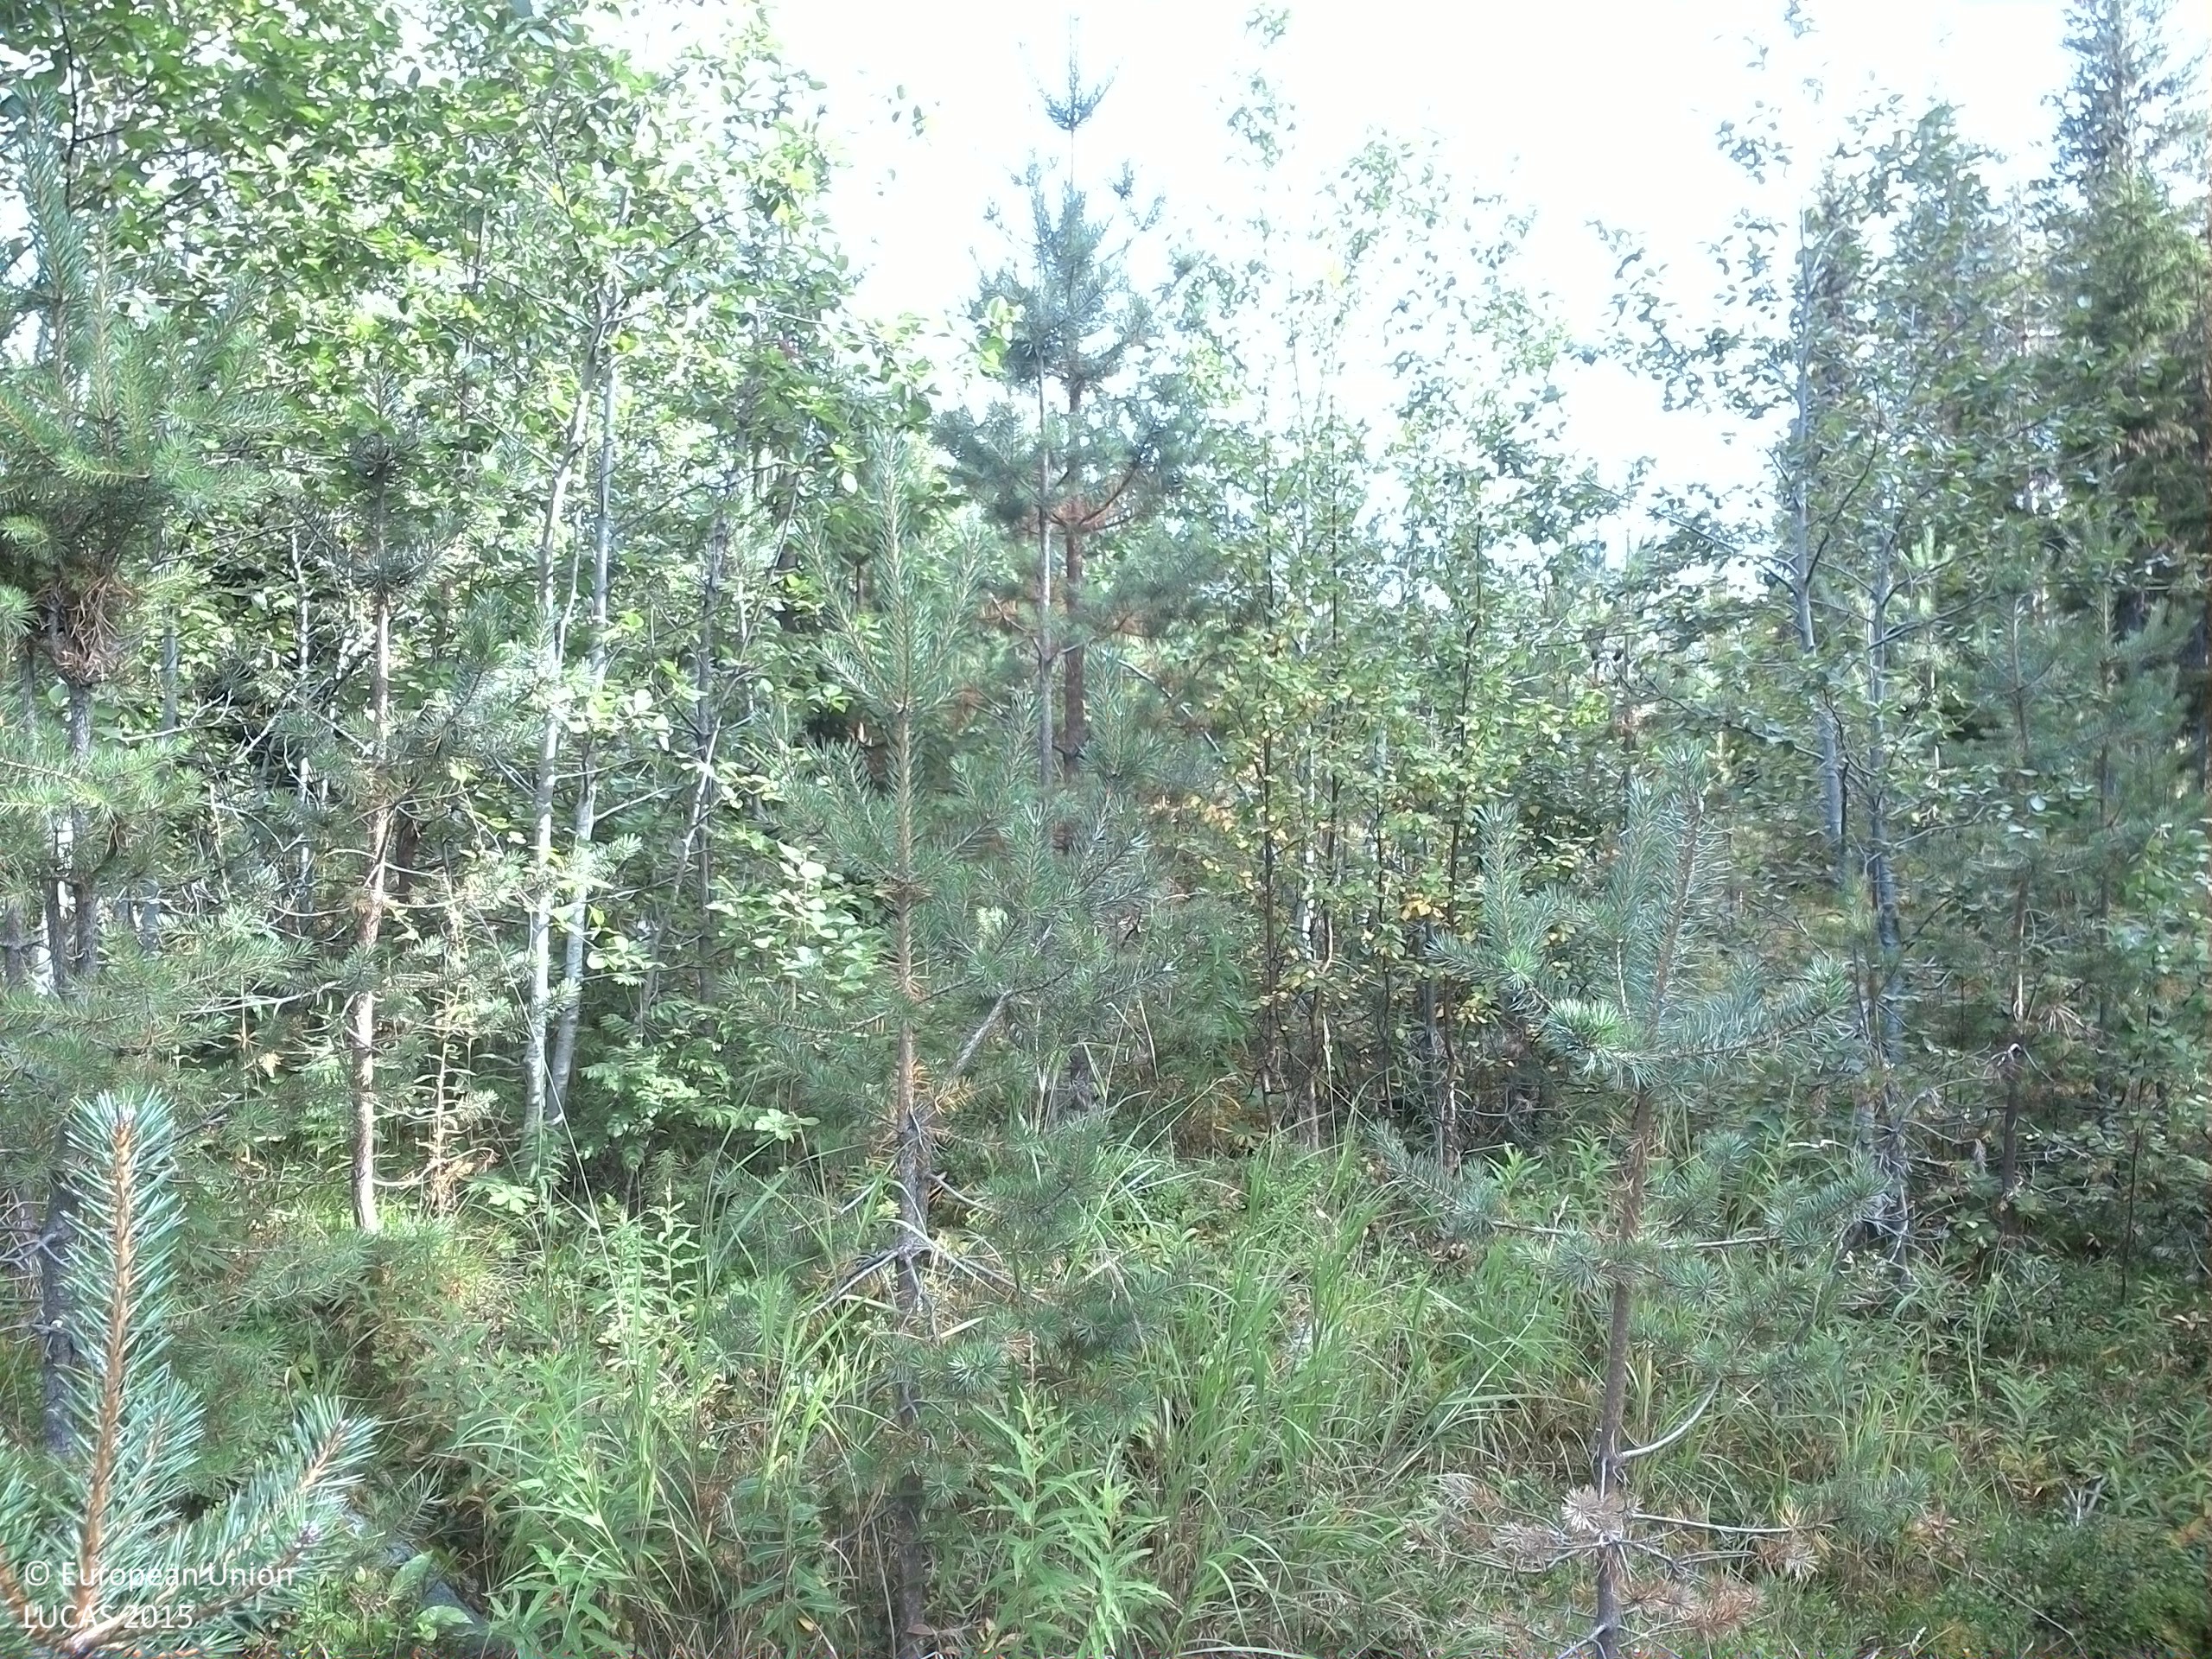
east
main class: Woodland
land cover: Pine dominated mixed woodland
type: boreal forest
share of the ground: 50 - 75 %
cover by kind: coniferous forest trees 35 %, broadleaved forest trees 35 %, shrubs 20 %, herbaceous plants 10 %
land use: Forestry
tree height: < 5 m
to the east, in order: Pine dominated mixed woodland; Rivers and streams; Pine dominated mixed woodland; Pine dominated coniferous woodland
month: August
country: SE
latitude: 64.0476
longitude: 17.3228
